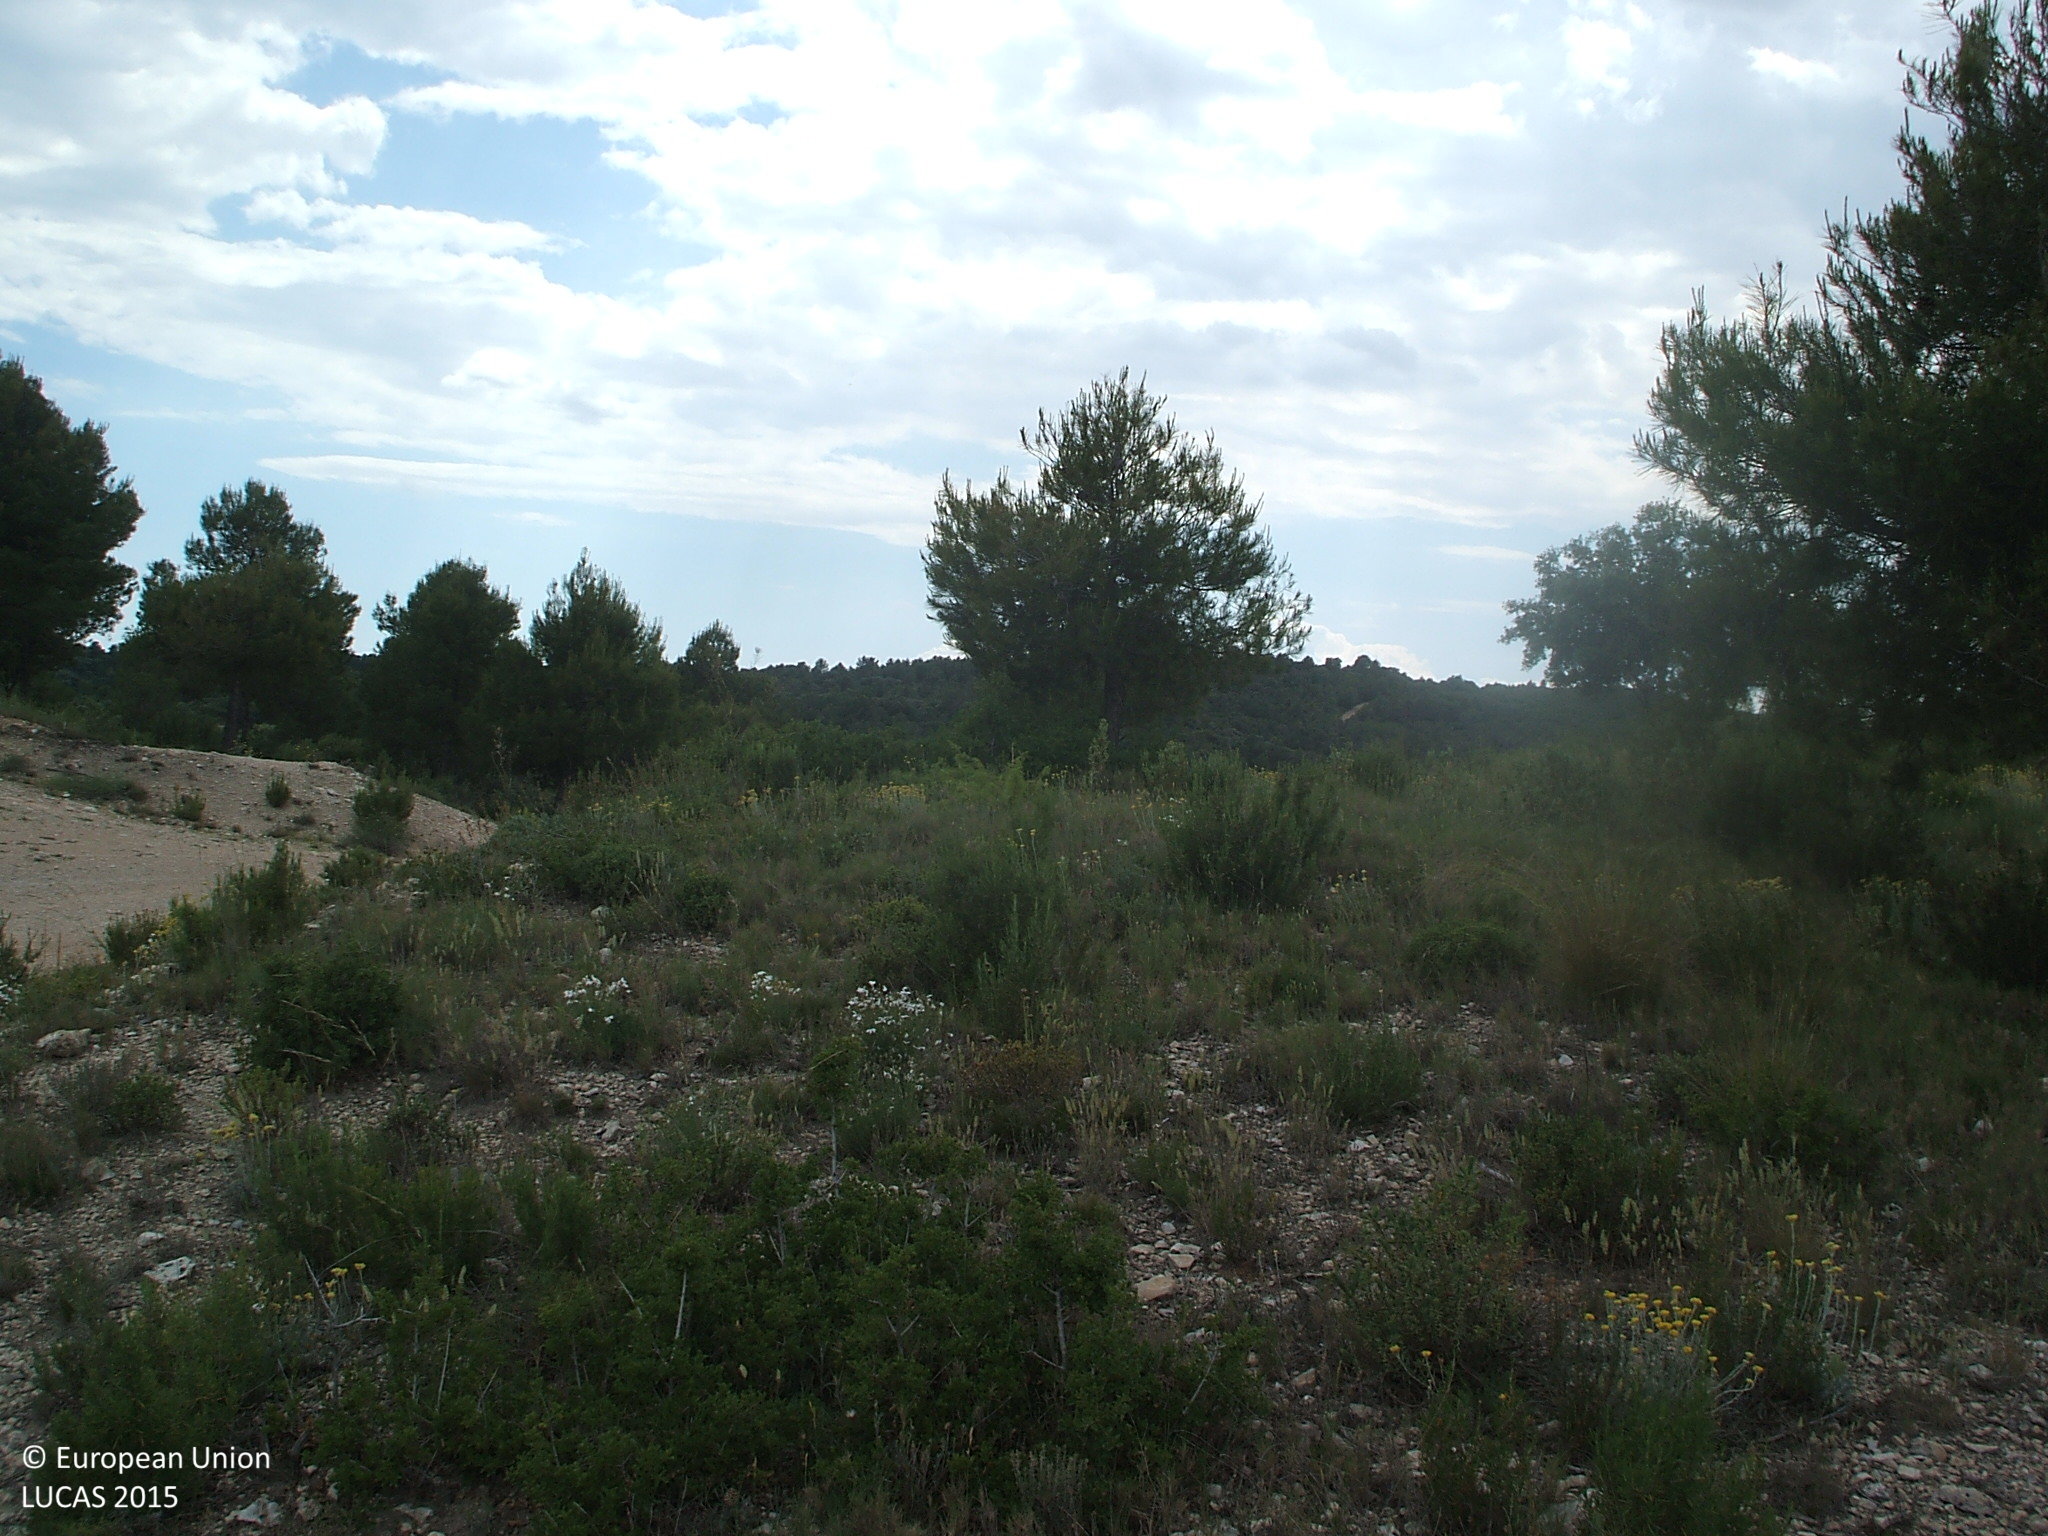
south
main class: Woodland
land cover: Pine dominated coniferous woodland
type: coniferous forest of the mediterranean region
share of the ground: > 75 %
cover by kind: coniferous forest trees 100 %
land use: Semi-natural and natural areas not in use
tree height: > 5 m
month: June
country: ES
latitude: 40.8865
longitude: -0.1573
